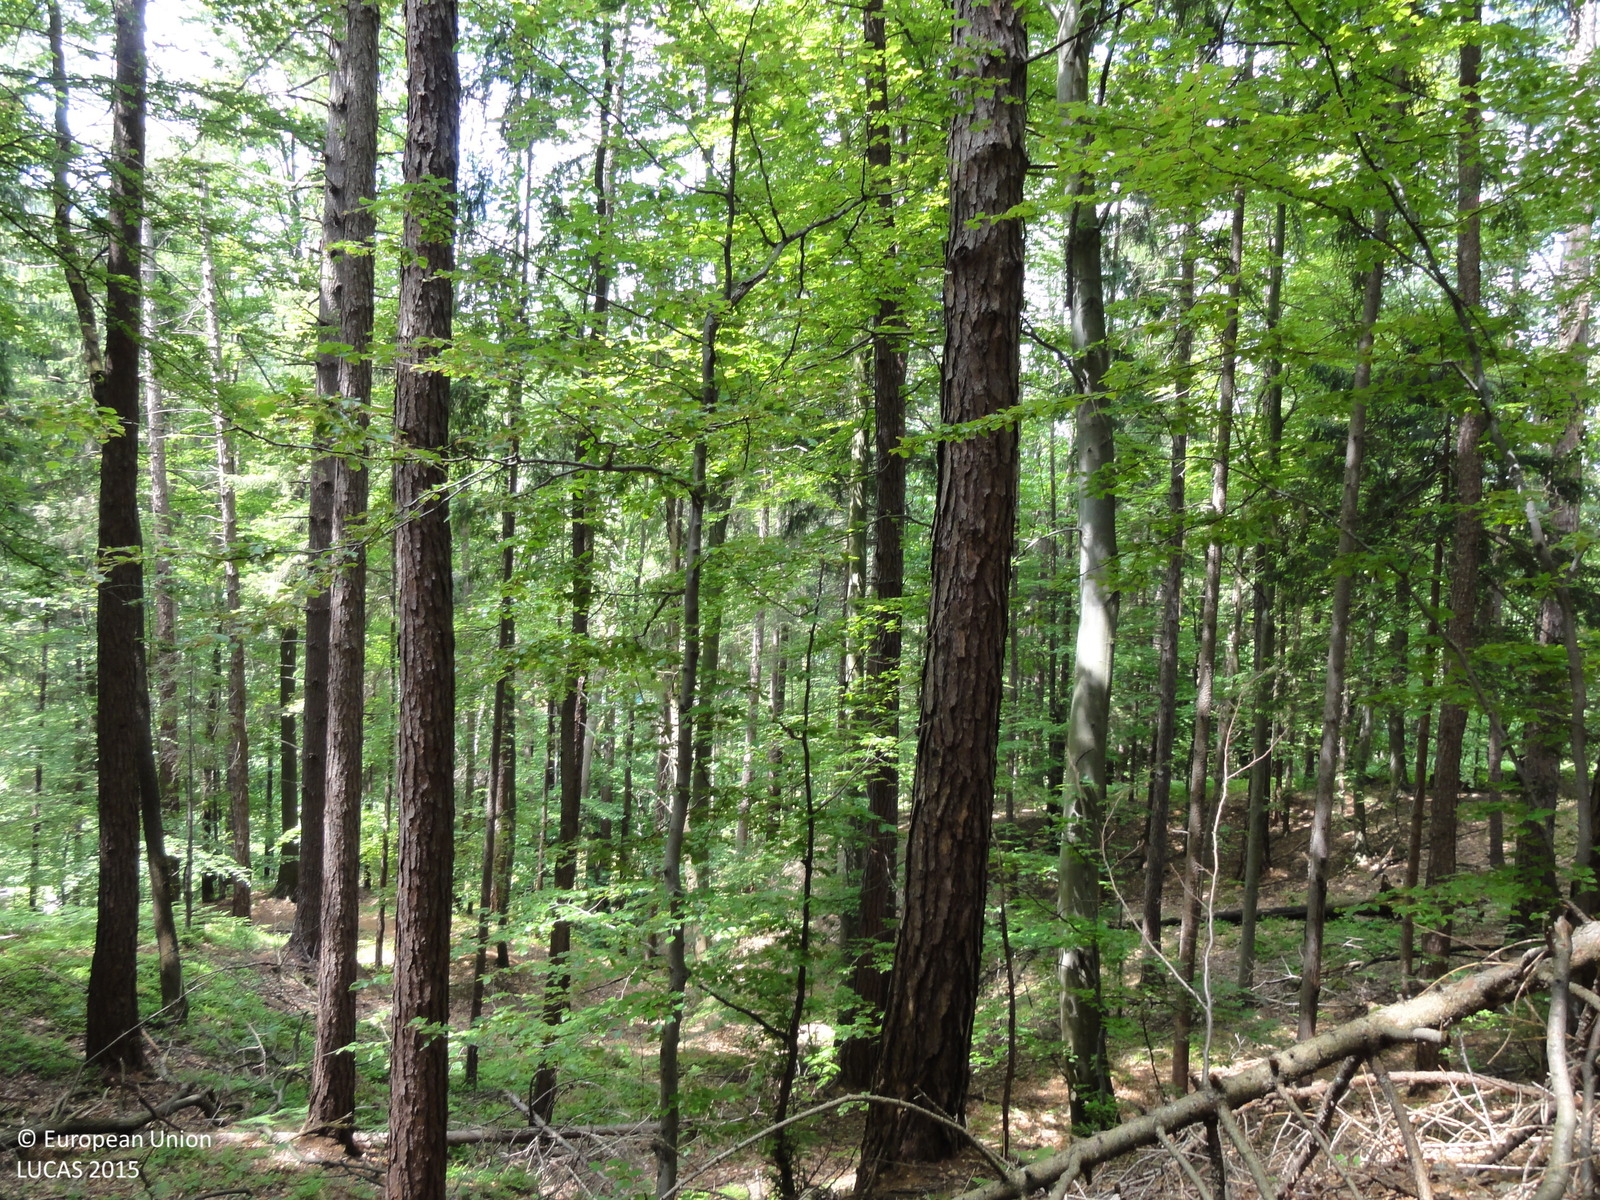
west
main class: Woodland
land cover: Other mixed woodland
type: mountainous beech forest
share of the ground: > 75 %
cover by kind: coniferous forest trees 50 %, broadleaved forest trees 50 %
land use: Forestry
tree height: > 5 m
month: May
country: SI
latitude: 46.2299
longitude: 15.0932
